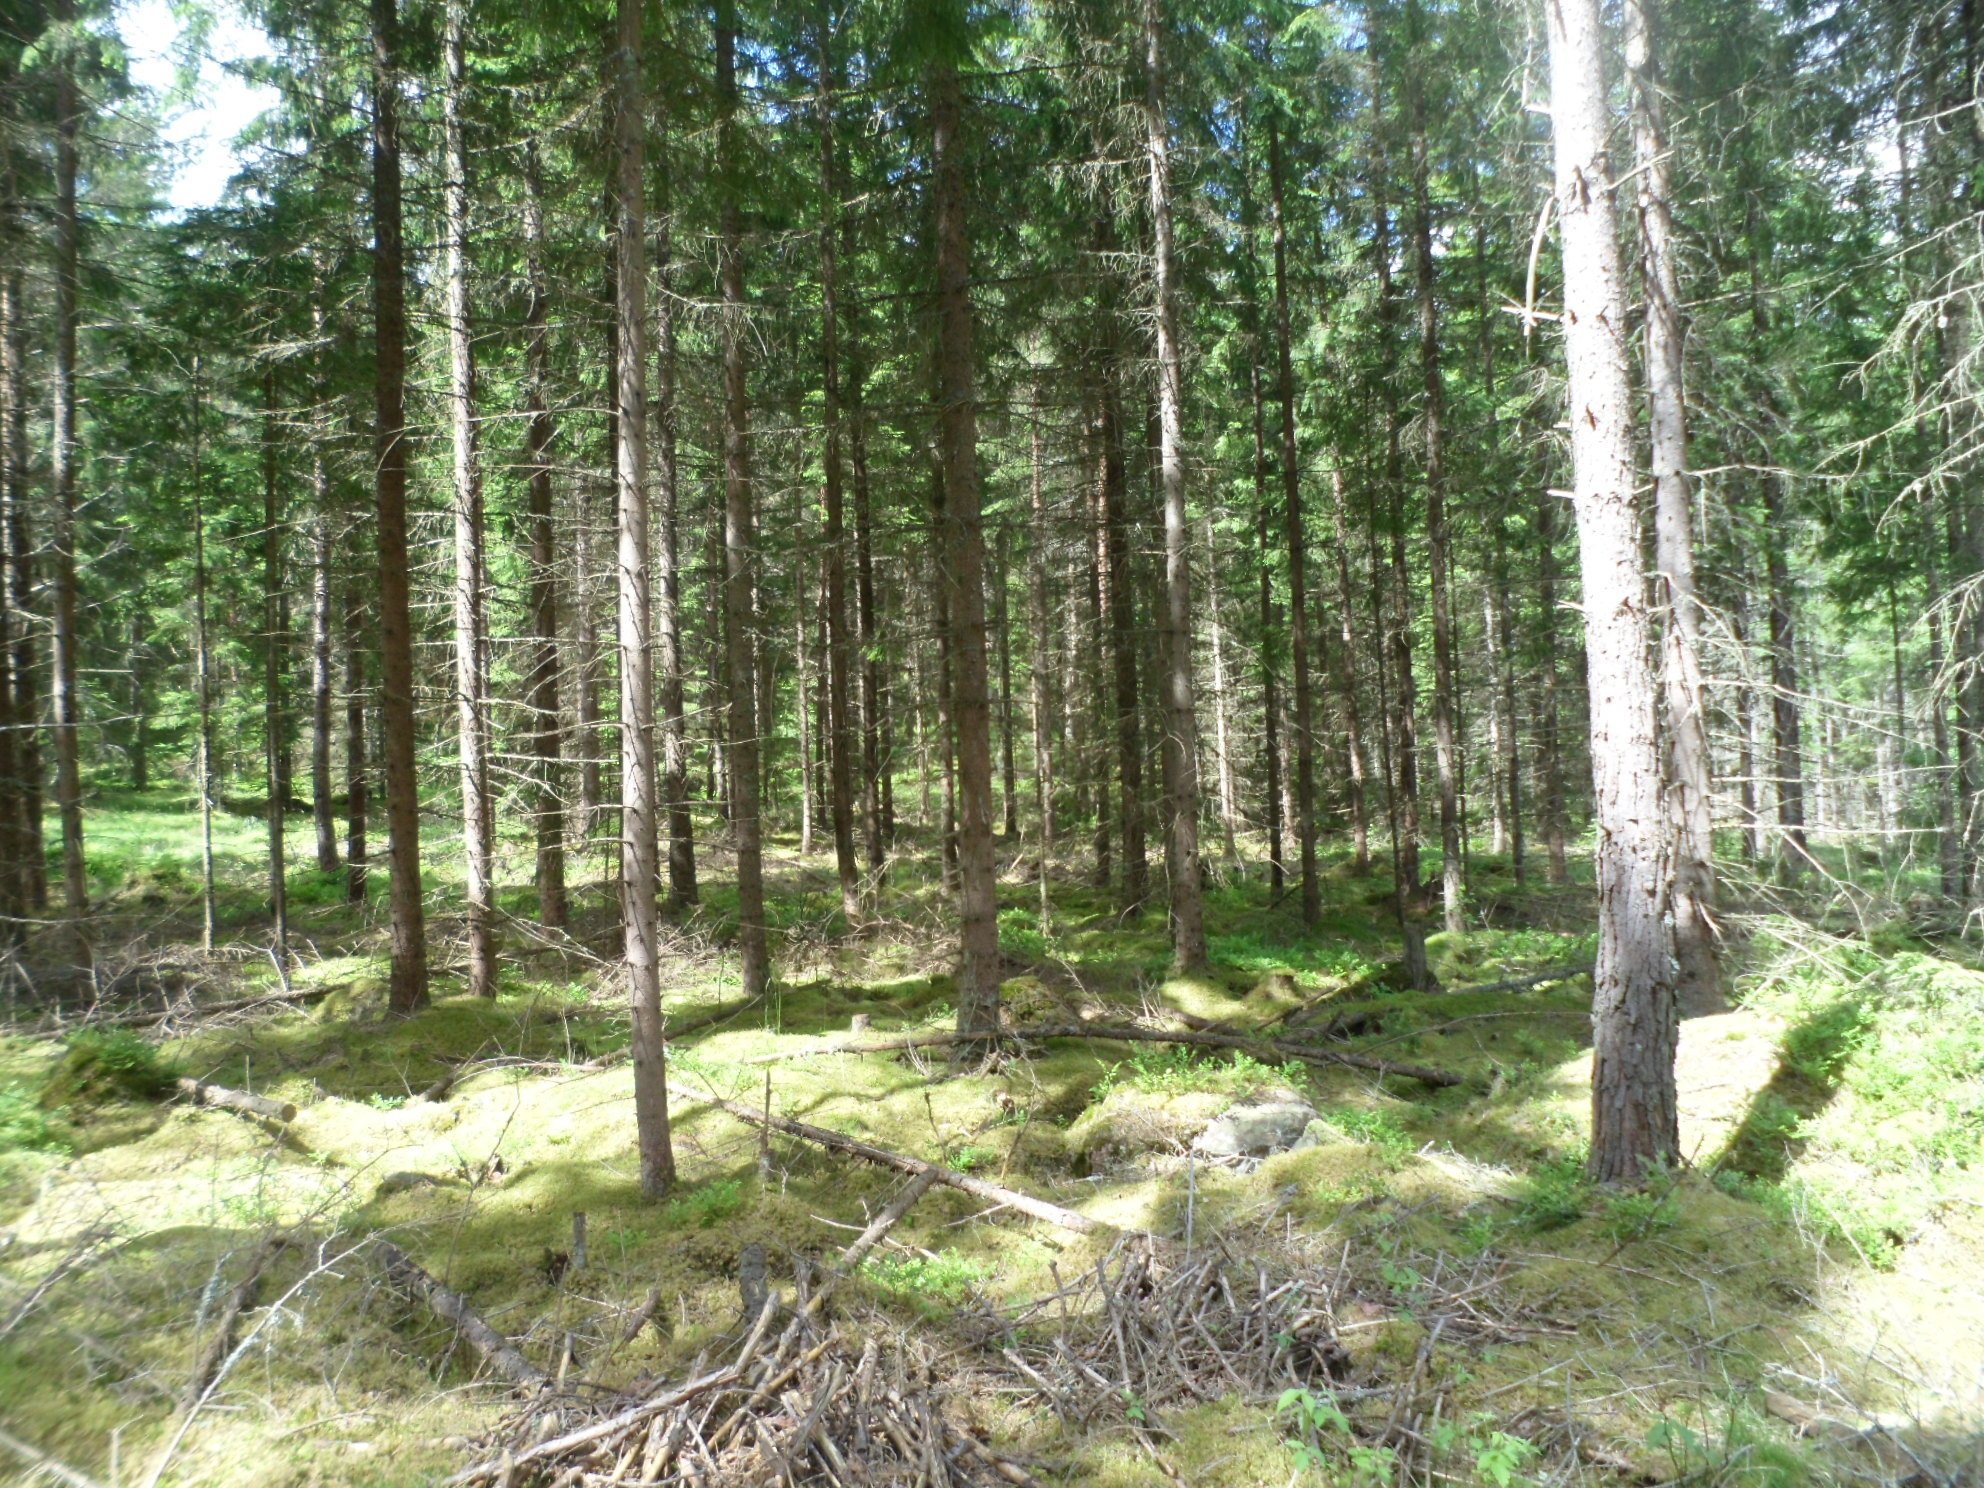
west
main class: Woodland
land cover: Pine dominated coniferous woodland
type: boreal forest
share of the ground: 50 - 75 %
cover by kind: coniferous forest trees 55 %, lichens and mosses 20 %, shrubs 15 %, herbaceous plants 10 %
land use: Forestry
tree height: > 5 m
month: June
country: SE
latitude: 57.1606
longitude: 14.8080
